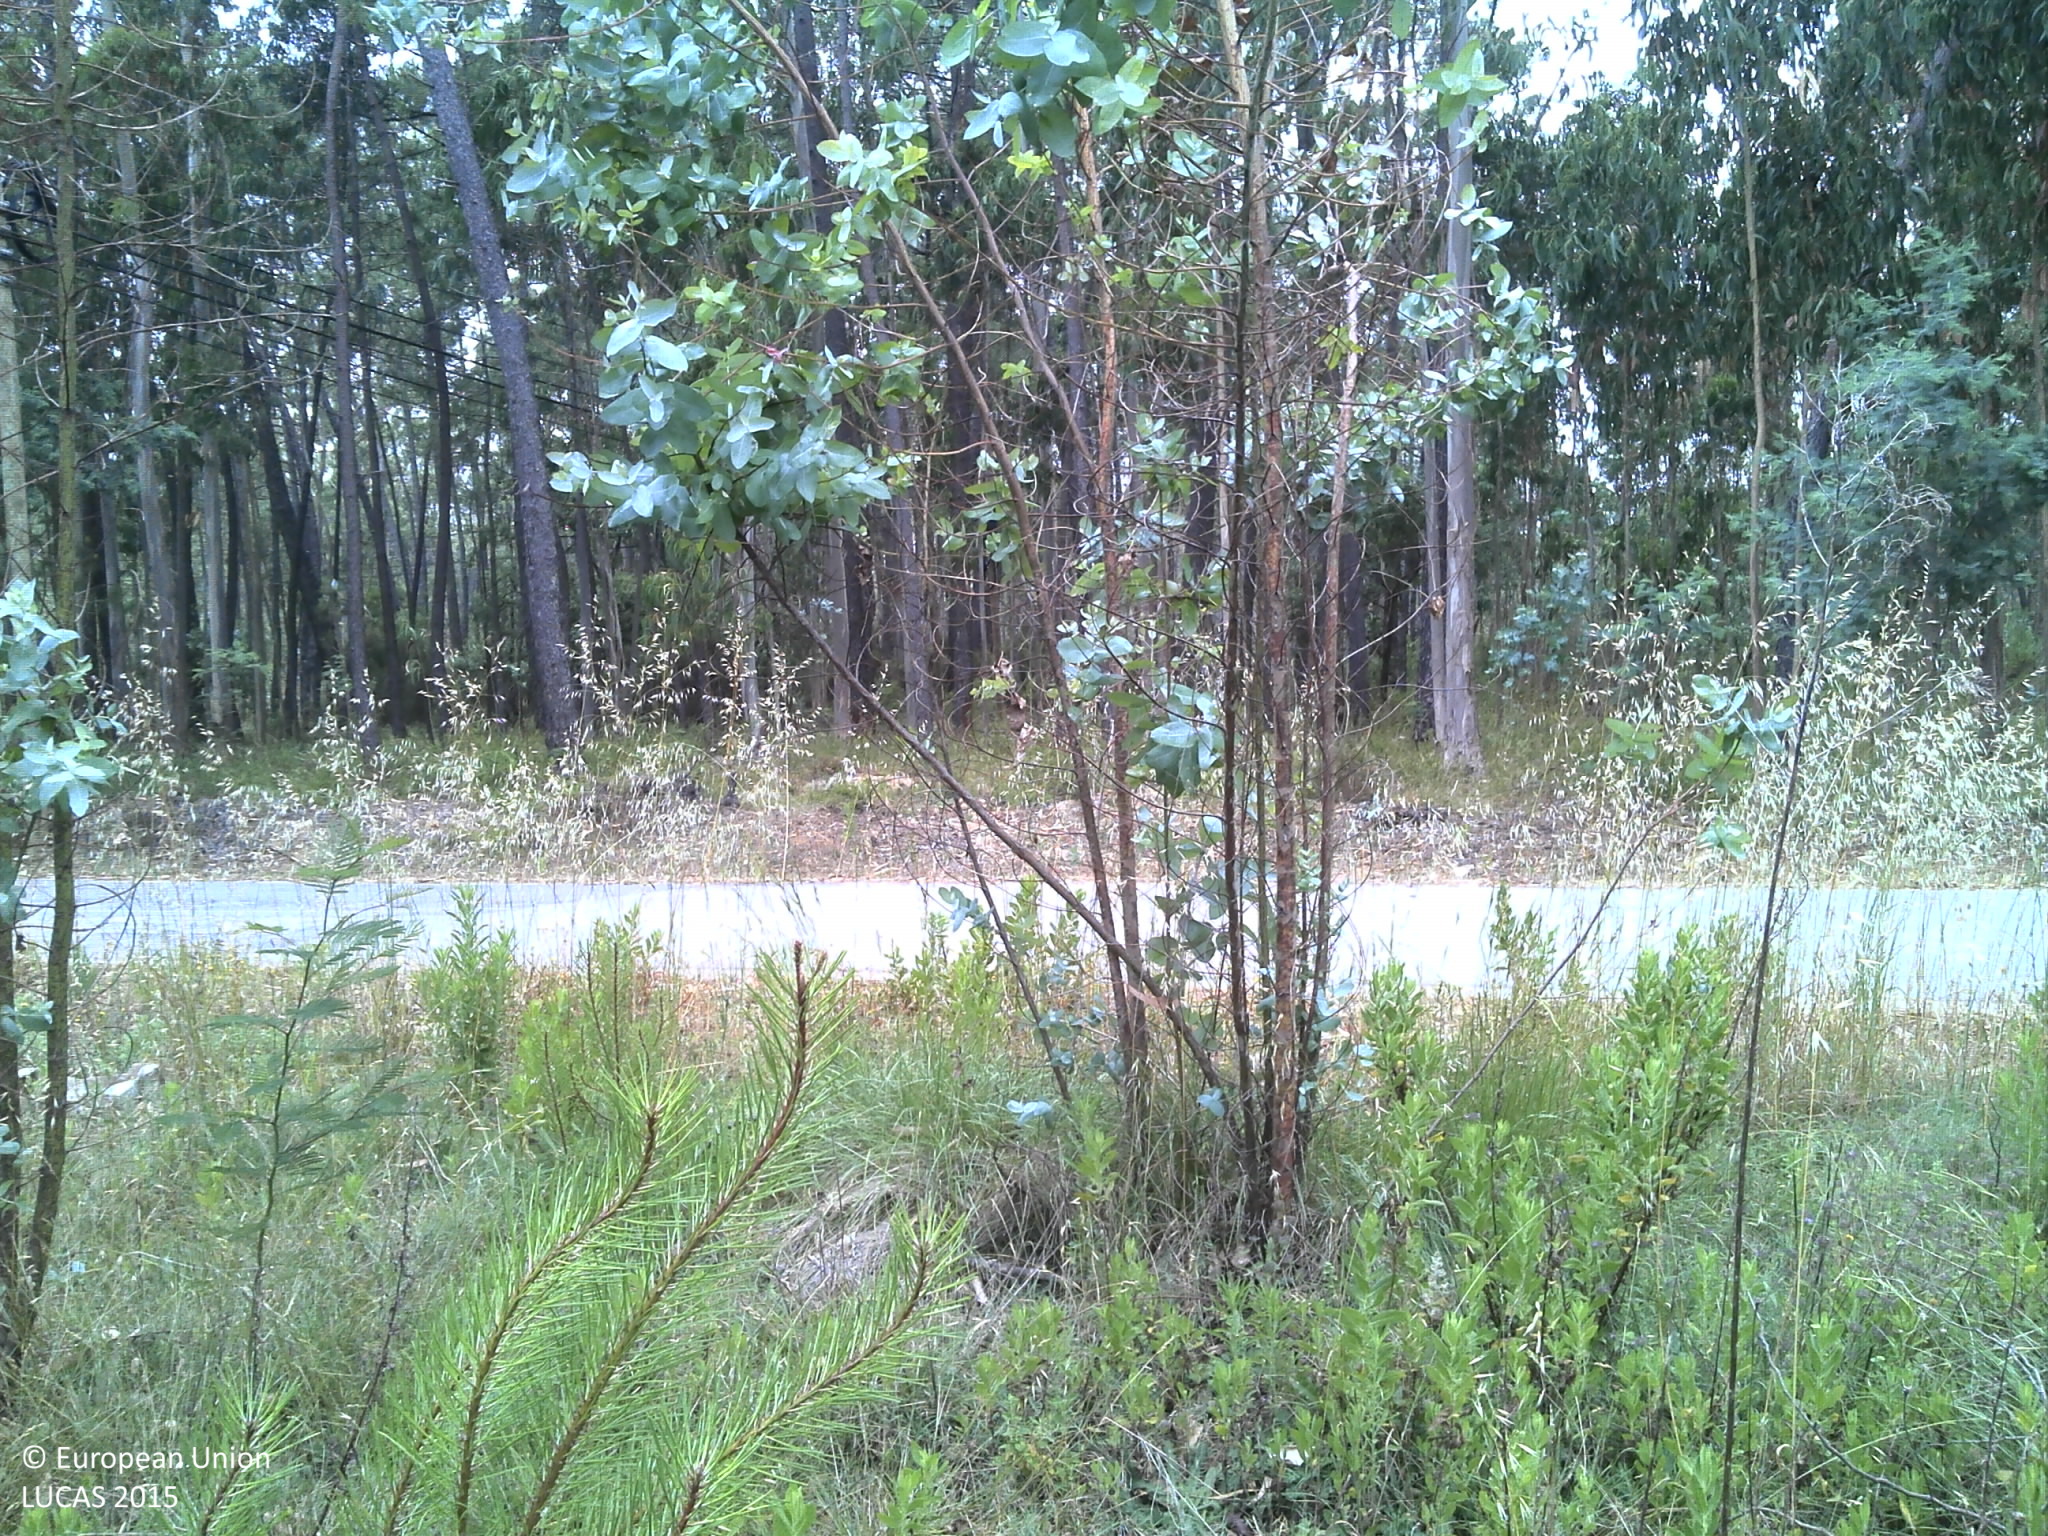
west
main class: Woodland
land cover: Broadleaved woodland
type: exotic forest
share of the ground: 50 - 75 %
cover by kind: broadleaved forest trees 70 %, shrubs 20 %, unconsolidated bare surface 10 %
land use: Forestry
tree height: > 5 m
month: June
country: PT
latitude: 40.2332
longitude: -8.6730
